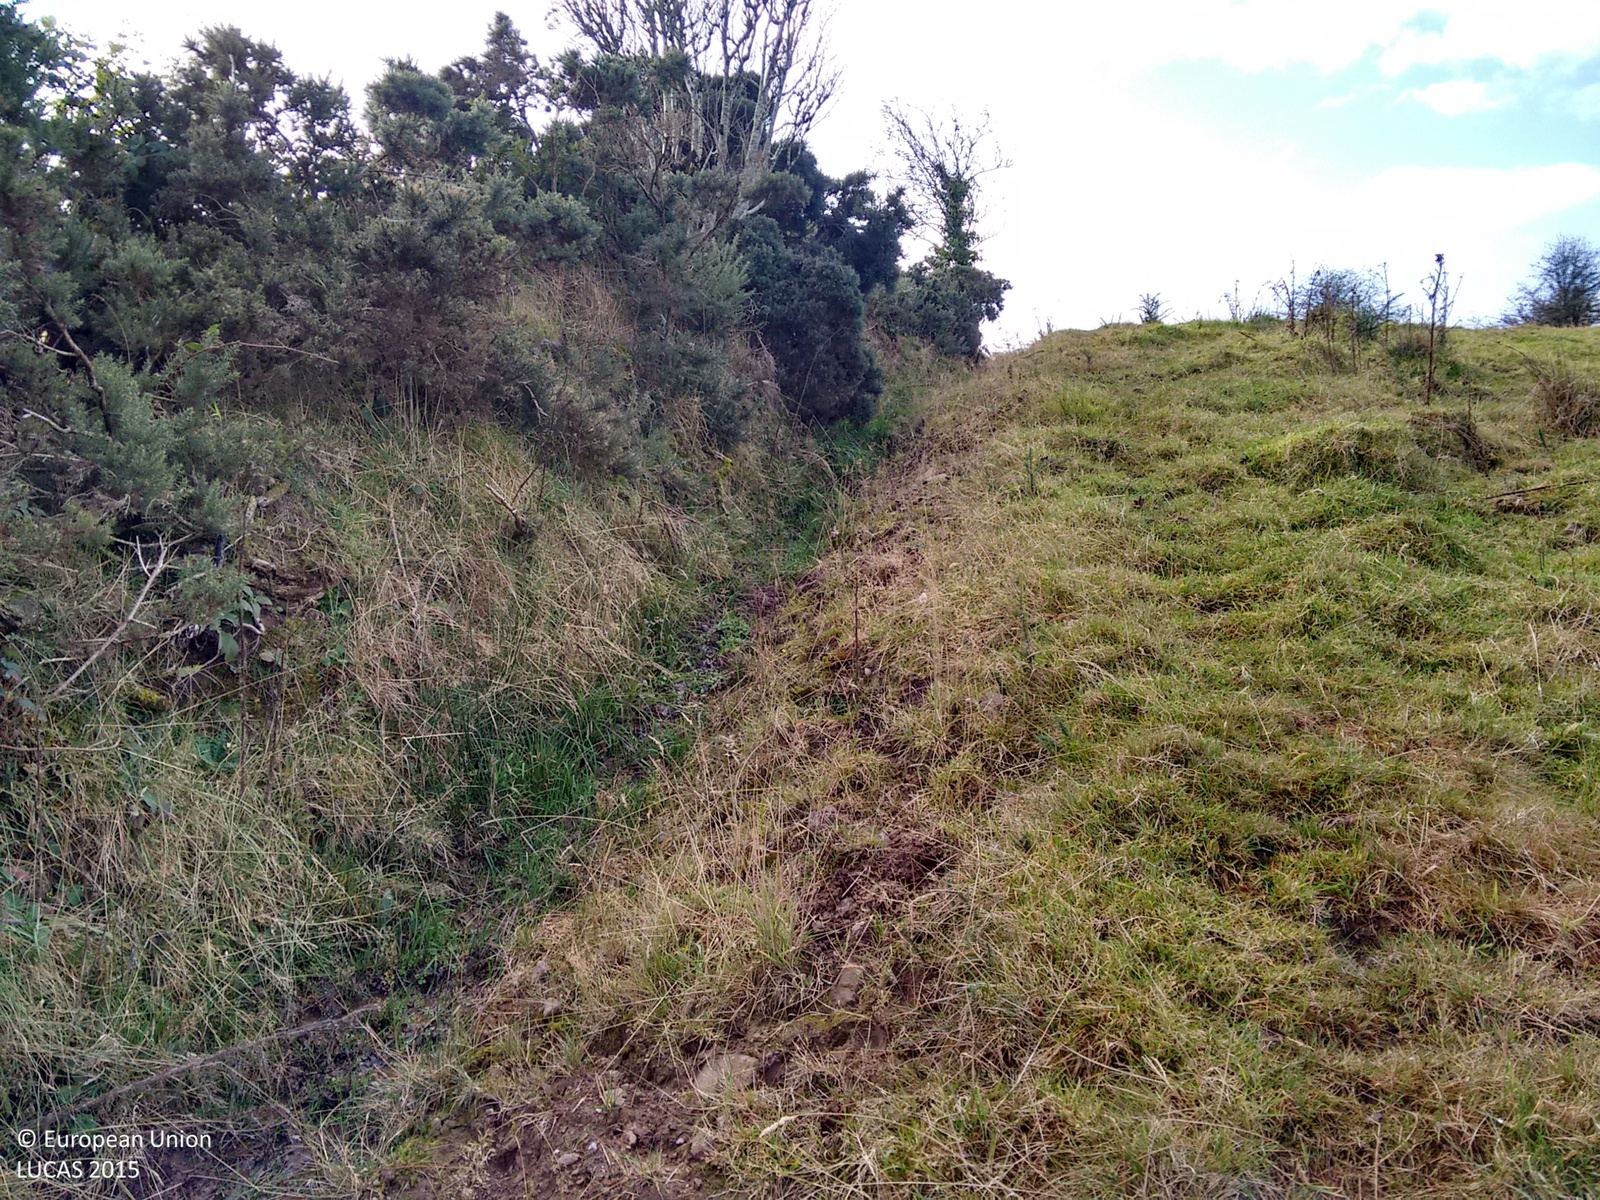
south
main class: Grassland
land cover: Grassland without tree/shrub cover
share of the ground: > 75 %
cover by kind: herbaceous plants 100 %
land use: Agriculture (excluding fallow land and kitchen gardens)
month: October
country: GB
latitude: 54.4526
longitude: -7.3800
